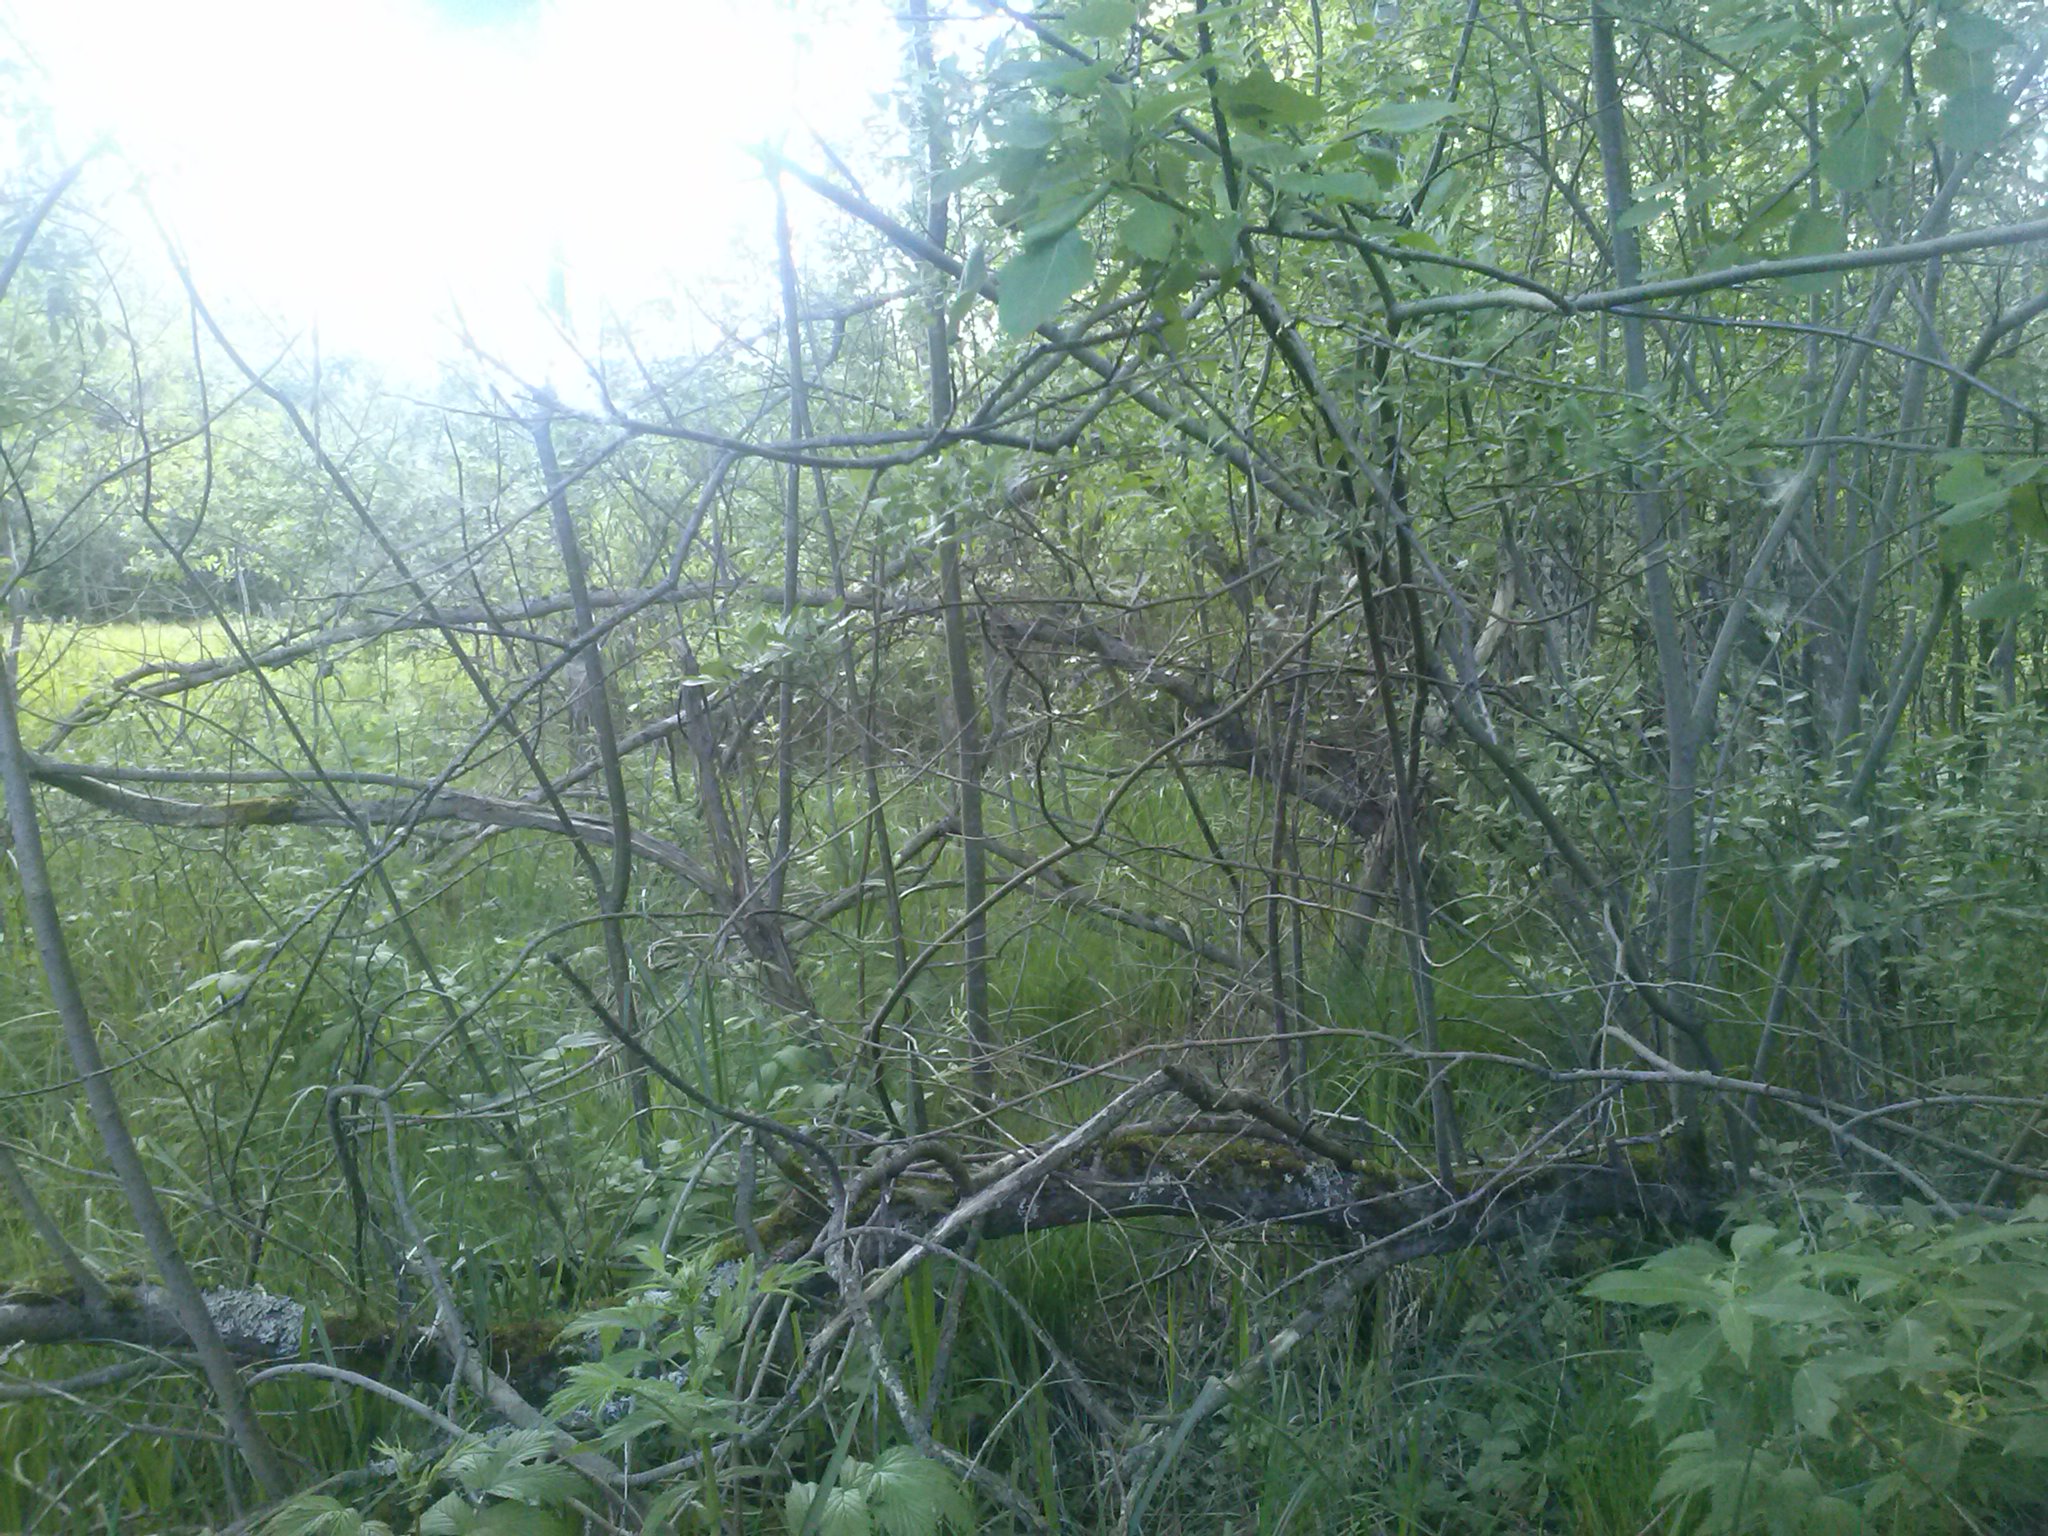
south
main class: Woodland
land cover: Broadleaved woodland
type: non-riverine alder, birch or aspen forest
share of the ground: > 75 %
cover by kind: broadleaved forest trees 90 %, herbaceous plants 10 %
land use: Forestry
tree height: > 5 m
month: June
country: LV
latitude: 56.3444
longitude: 27.5751
